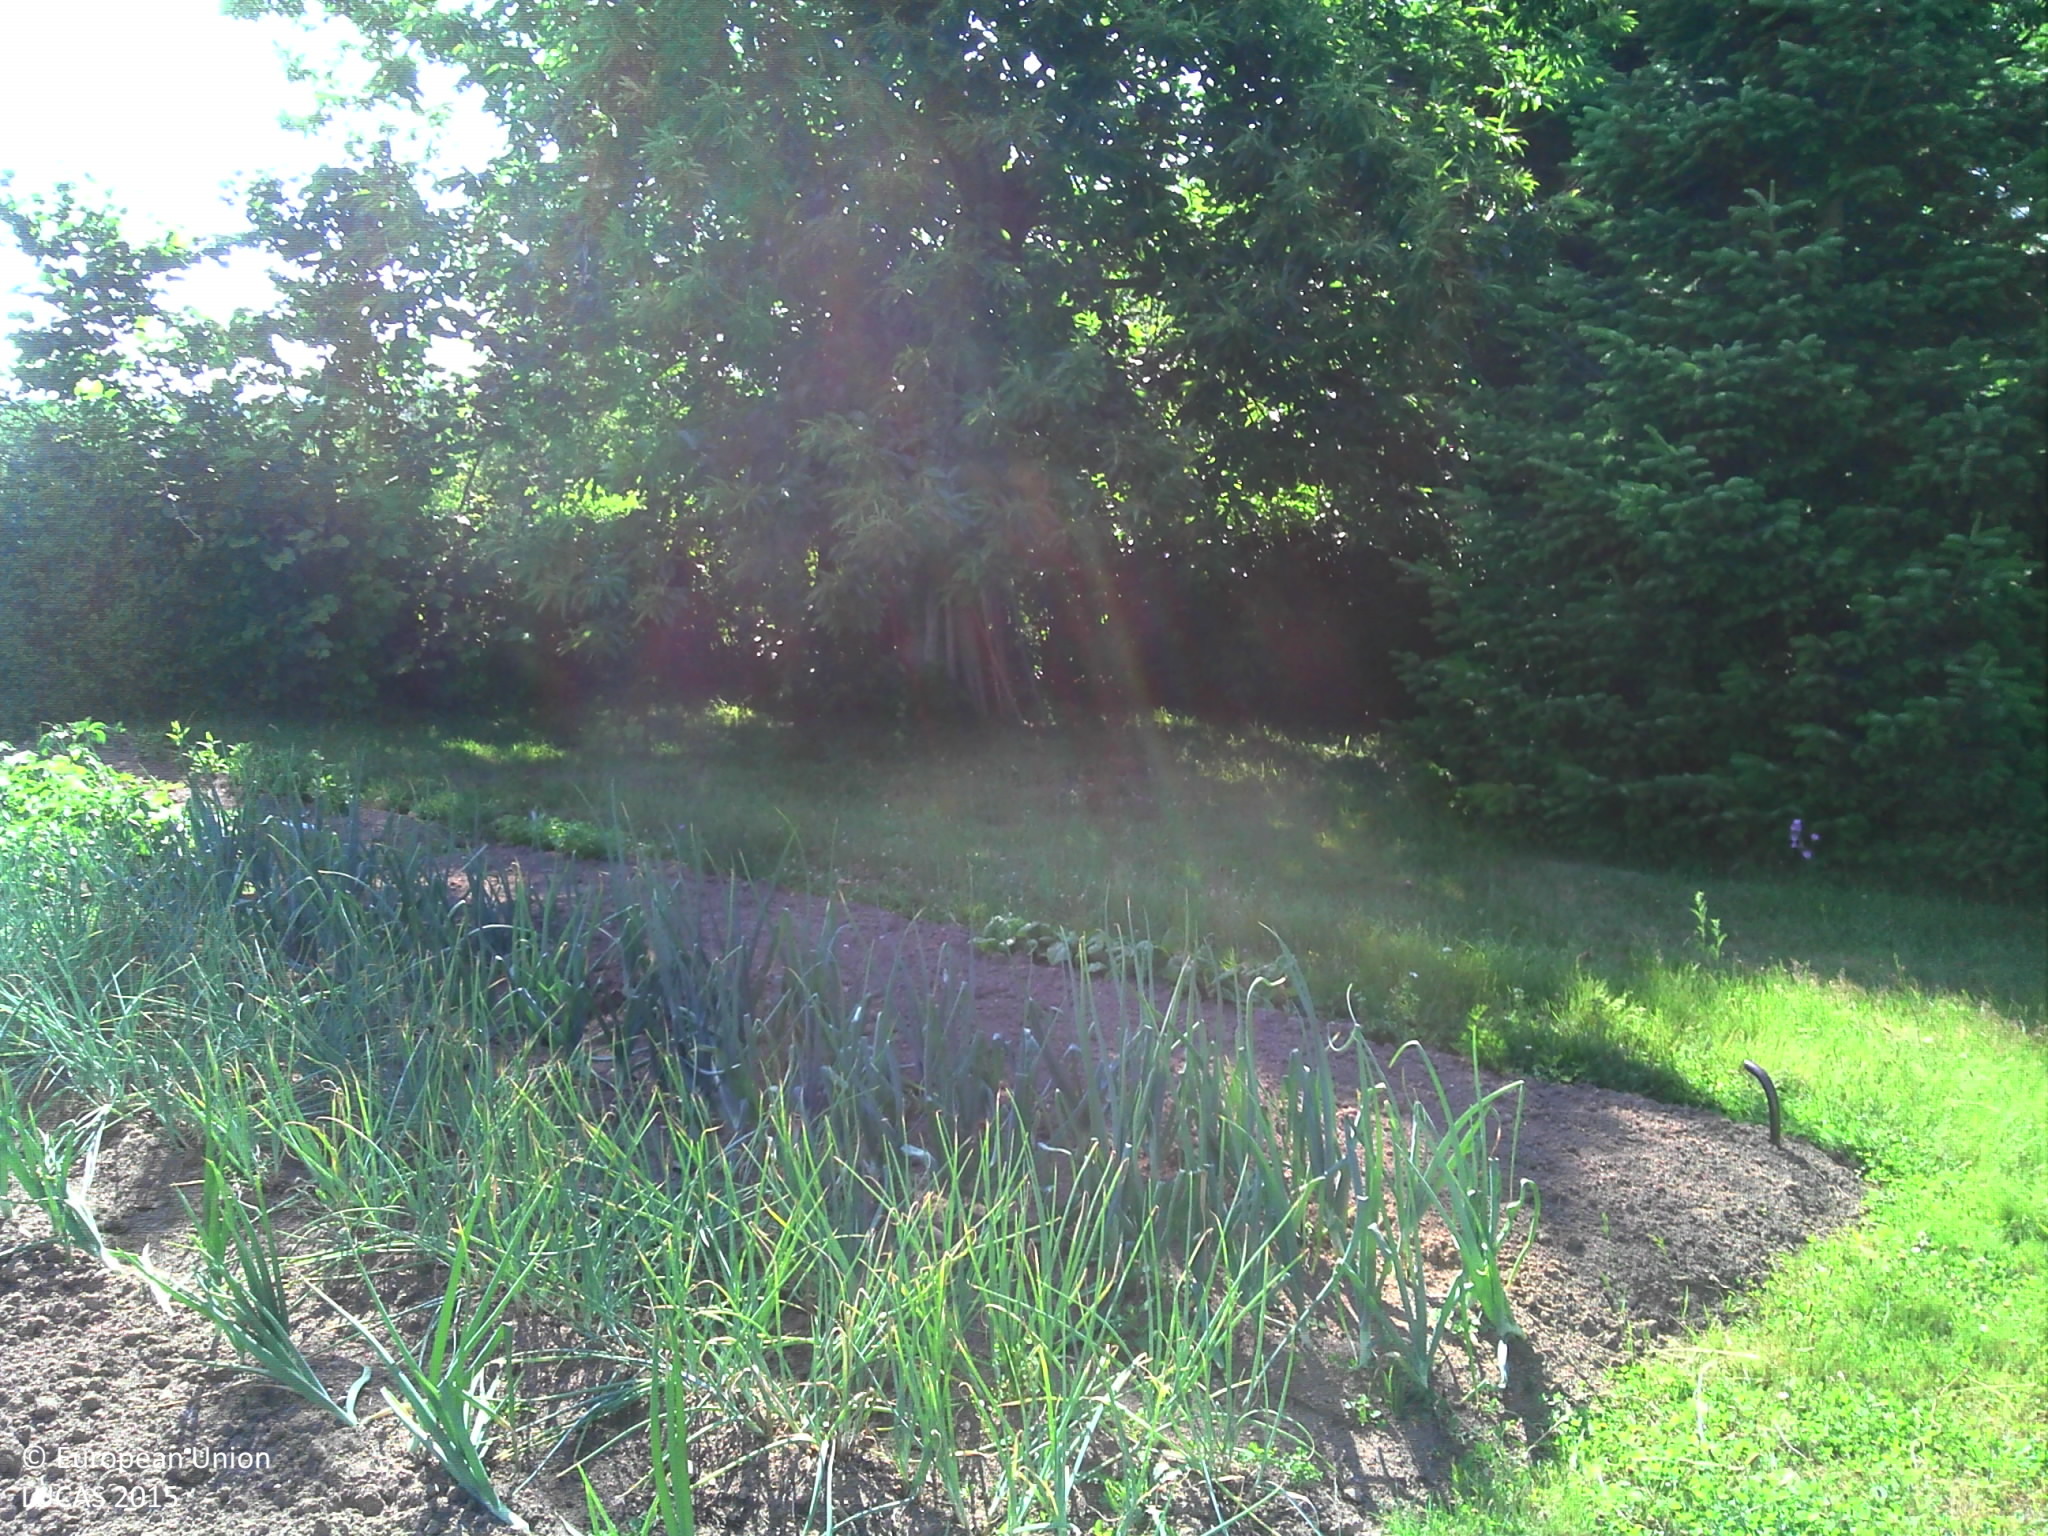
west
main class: Grassland
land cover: Grassland with sparse tree/shrub cover
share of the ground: > 75 %
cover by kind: herbaceous plants 95 %, broadleaved forest trees 5 %
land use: Agriculture (excluding fallow land and kitchen gardens)
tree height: > 5 m
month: June
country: FR
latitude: 45.8860
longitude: 0.6440
